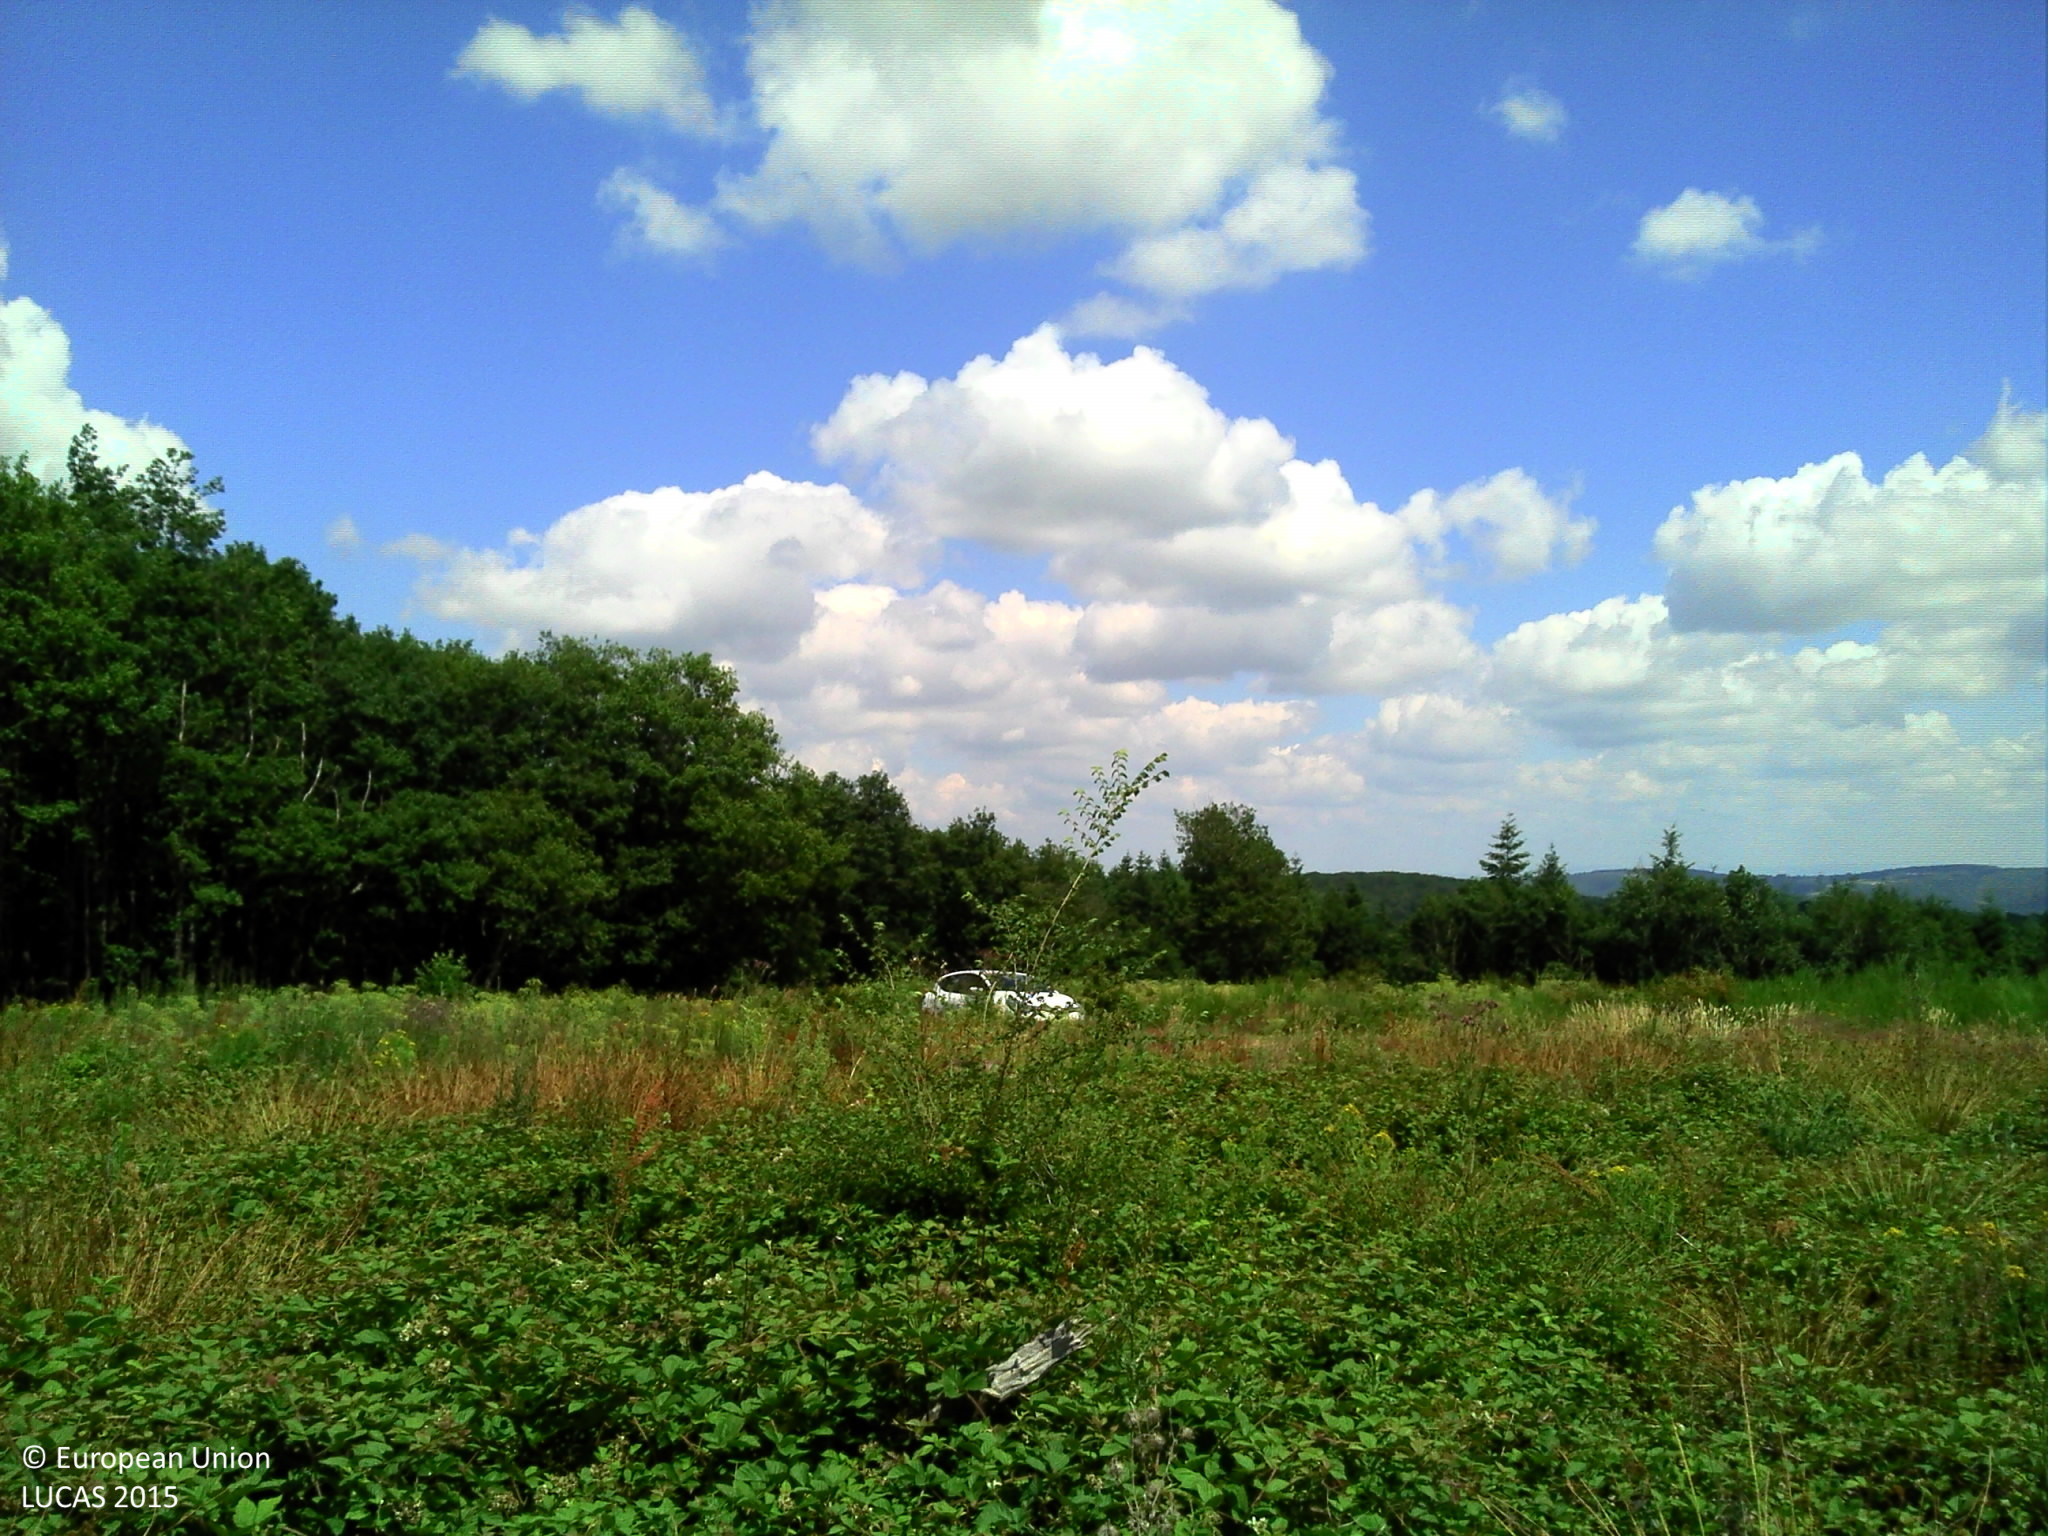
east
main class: Shrubland
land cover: Shrubland without tree cover
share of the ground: > 75 %
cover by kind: shrubs 90 %, herbaceous plants 10 %
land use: Forestry
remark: Clear cut
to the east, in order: Shrubland without tree cover; Tracks; Shrubland without tree cover; Shrubland with sparse tree cover; Spruce dominated mixed woodland; Grassland without tree/shrub cover; Ditches and canals; Grass margins; Paved roads, cycling and walking lanes; Grass margins; Ditches and canals; Grassland without tree/shrub cover
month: June
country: FR
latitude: 46.1233
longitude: 3.0231
